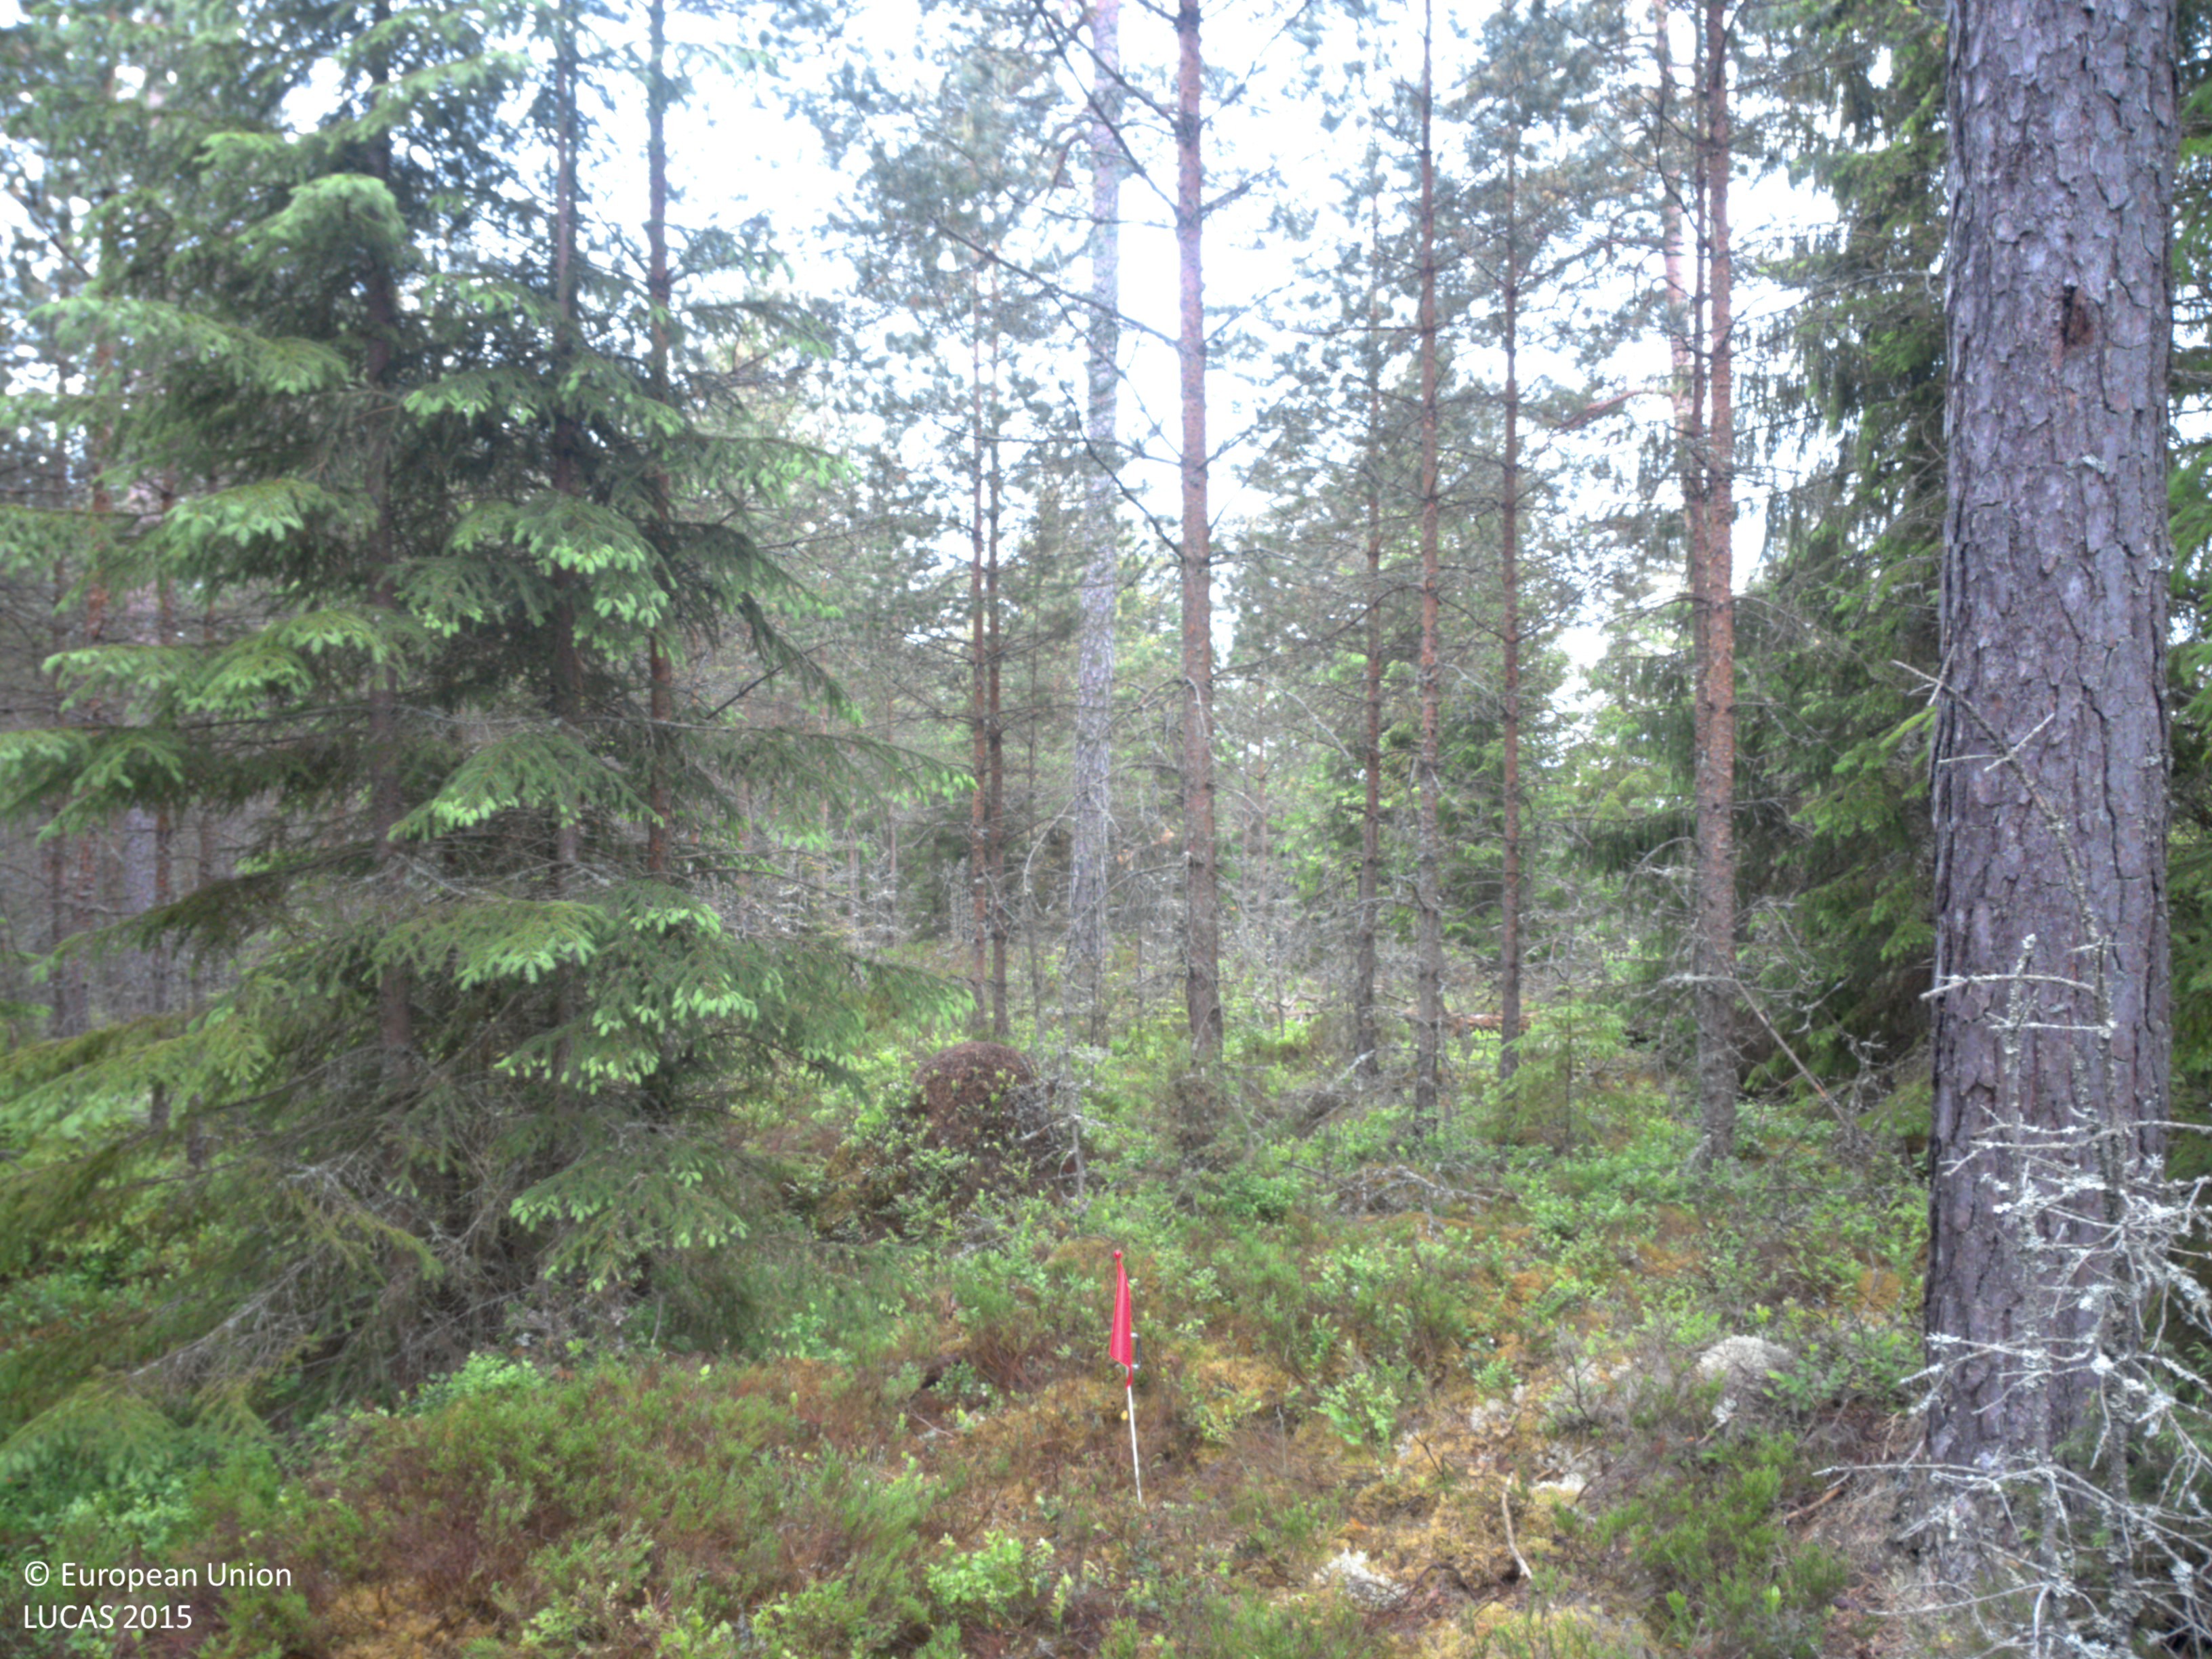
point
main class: Woodland
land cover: Pine dominated coniferous woodland
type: boreal forest
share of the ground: 50 - 75 %
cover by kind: coniferous forest trees 50 %, lichens and mosses 30 %, shrubs 20 %
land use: Forestry
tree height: > 5 m
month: June
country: SE
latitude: 59.1038
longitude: 12.0379
